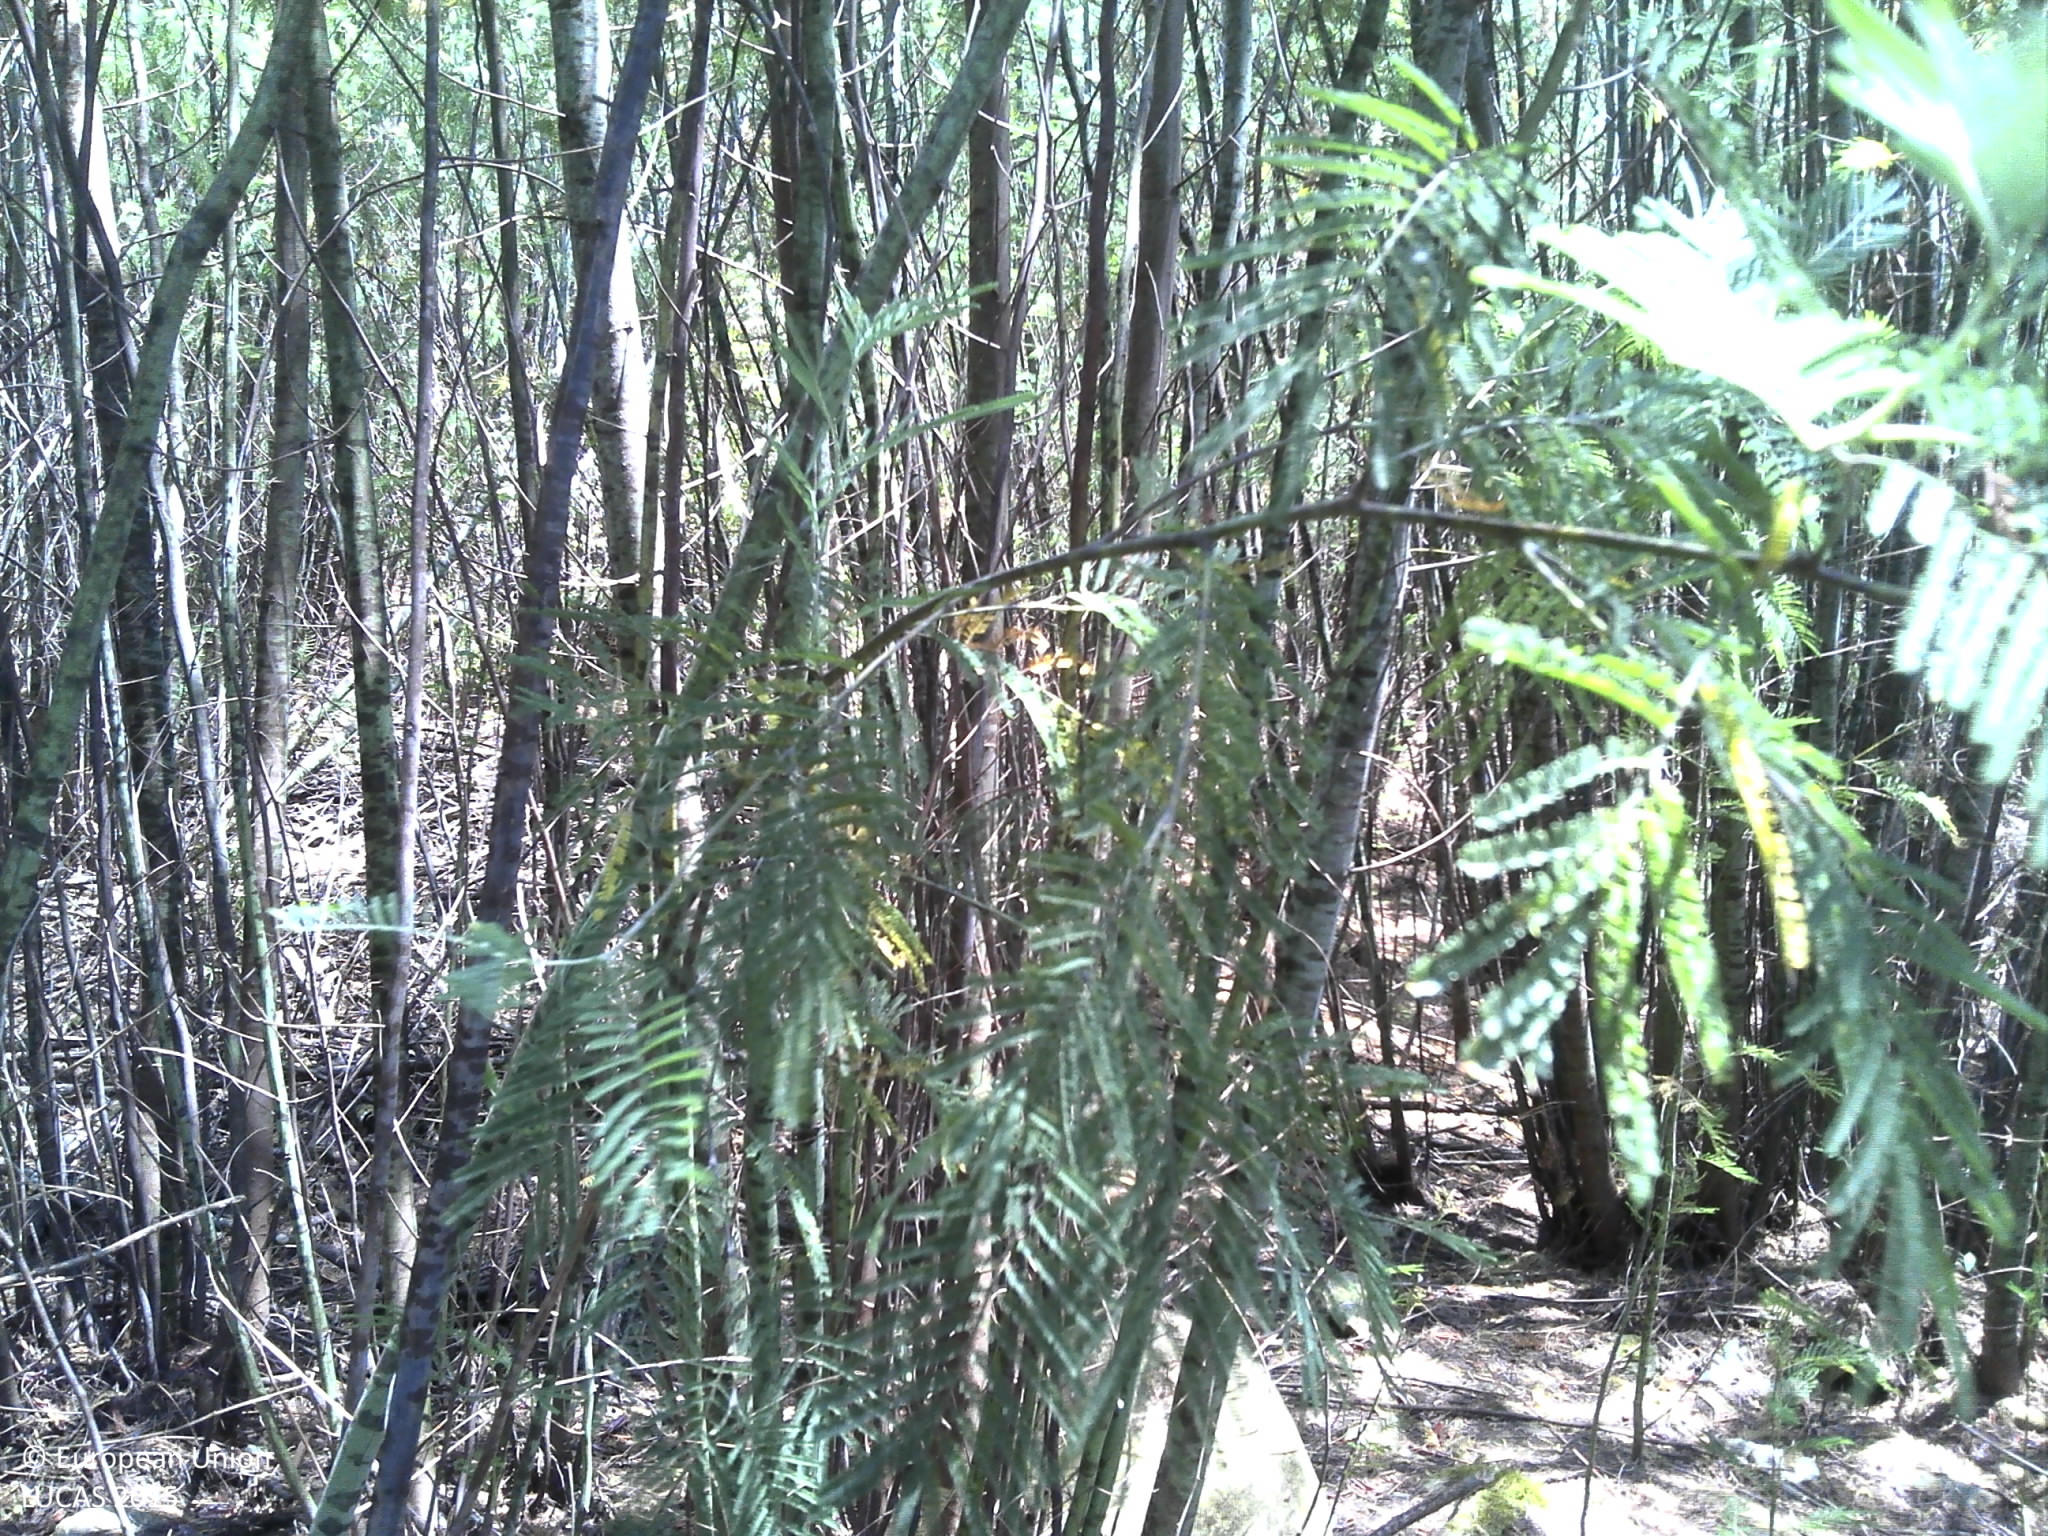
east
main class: Woodland
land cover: Broadleaved woodland
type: exotic forest
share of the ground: 25 - 50 %
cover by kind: broadleaved forest trees 50 %, unconsolidated bare surface 40 %, shrubs 10 %
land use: Forestry
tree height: > 5 m
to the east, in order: Broadleaved woodland; Artificial constructions; Grass margins; Tracks; Artificial constructions; Shrubland with sparse tree cover; Broadleaved woodland; Spontaneously vegetated surfaces; Tracks; Grass margins; Inland fresh water bodies
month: June
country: PT
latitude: 40.1544
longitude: -8.2146
